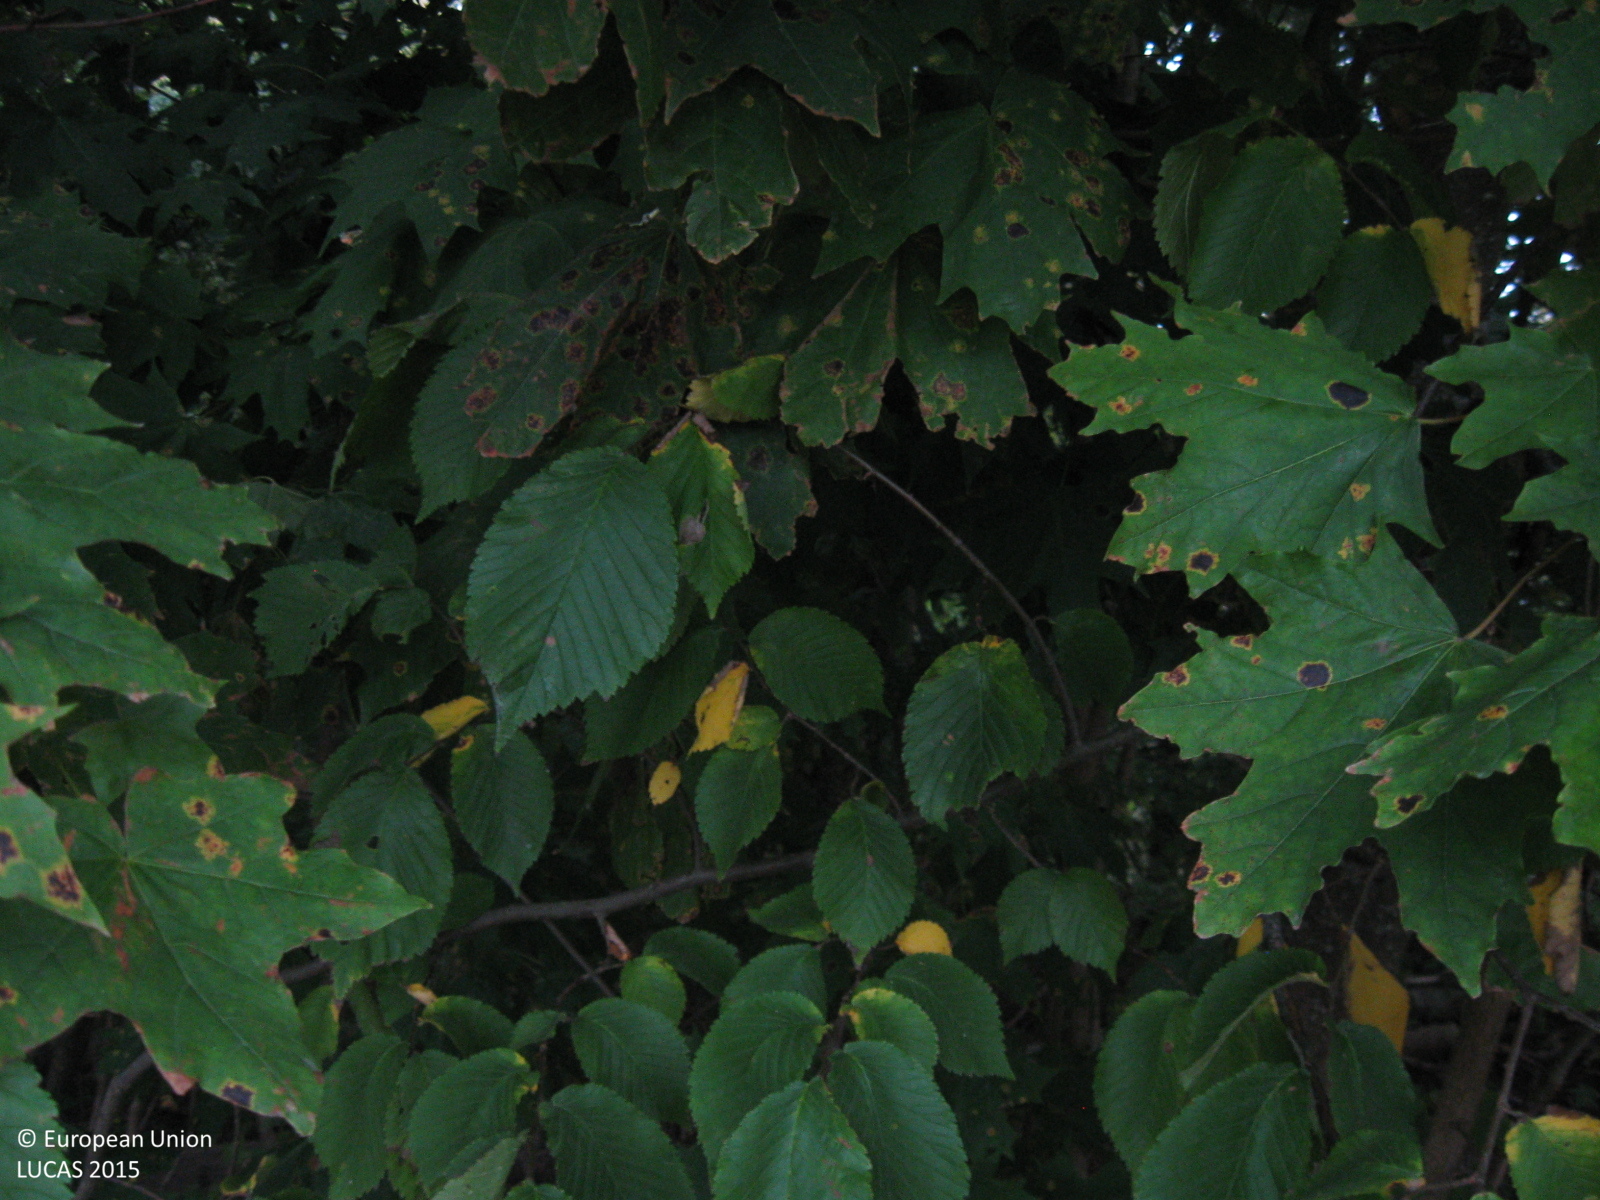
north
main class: Woodland
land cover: Broadleaved woodland
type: non-riverine alder, birch or aspen forest
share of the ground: > 75 %
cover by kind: broadleaved forest trees 95 %, herbaceous plants 5 %
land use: Forestry
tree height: > 5 m
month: September
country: LT
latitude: 55.0935
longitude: 23.0940
